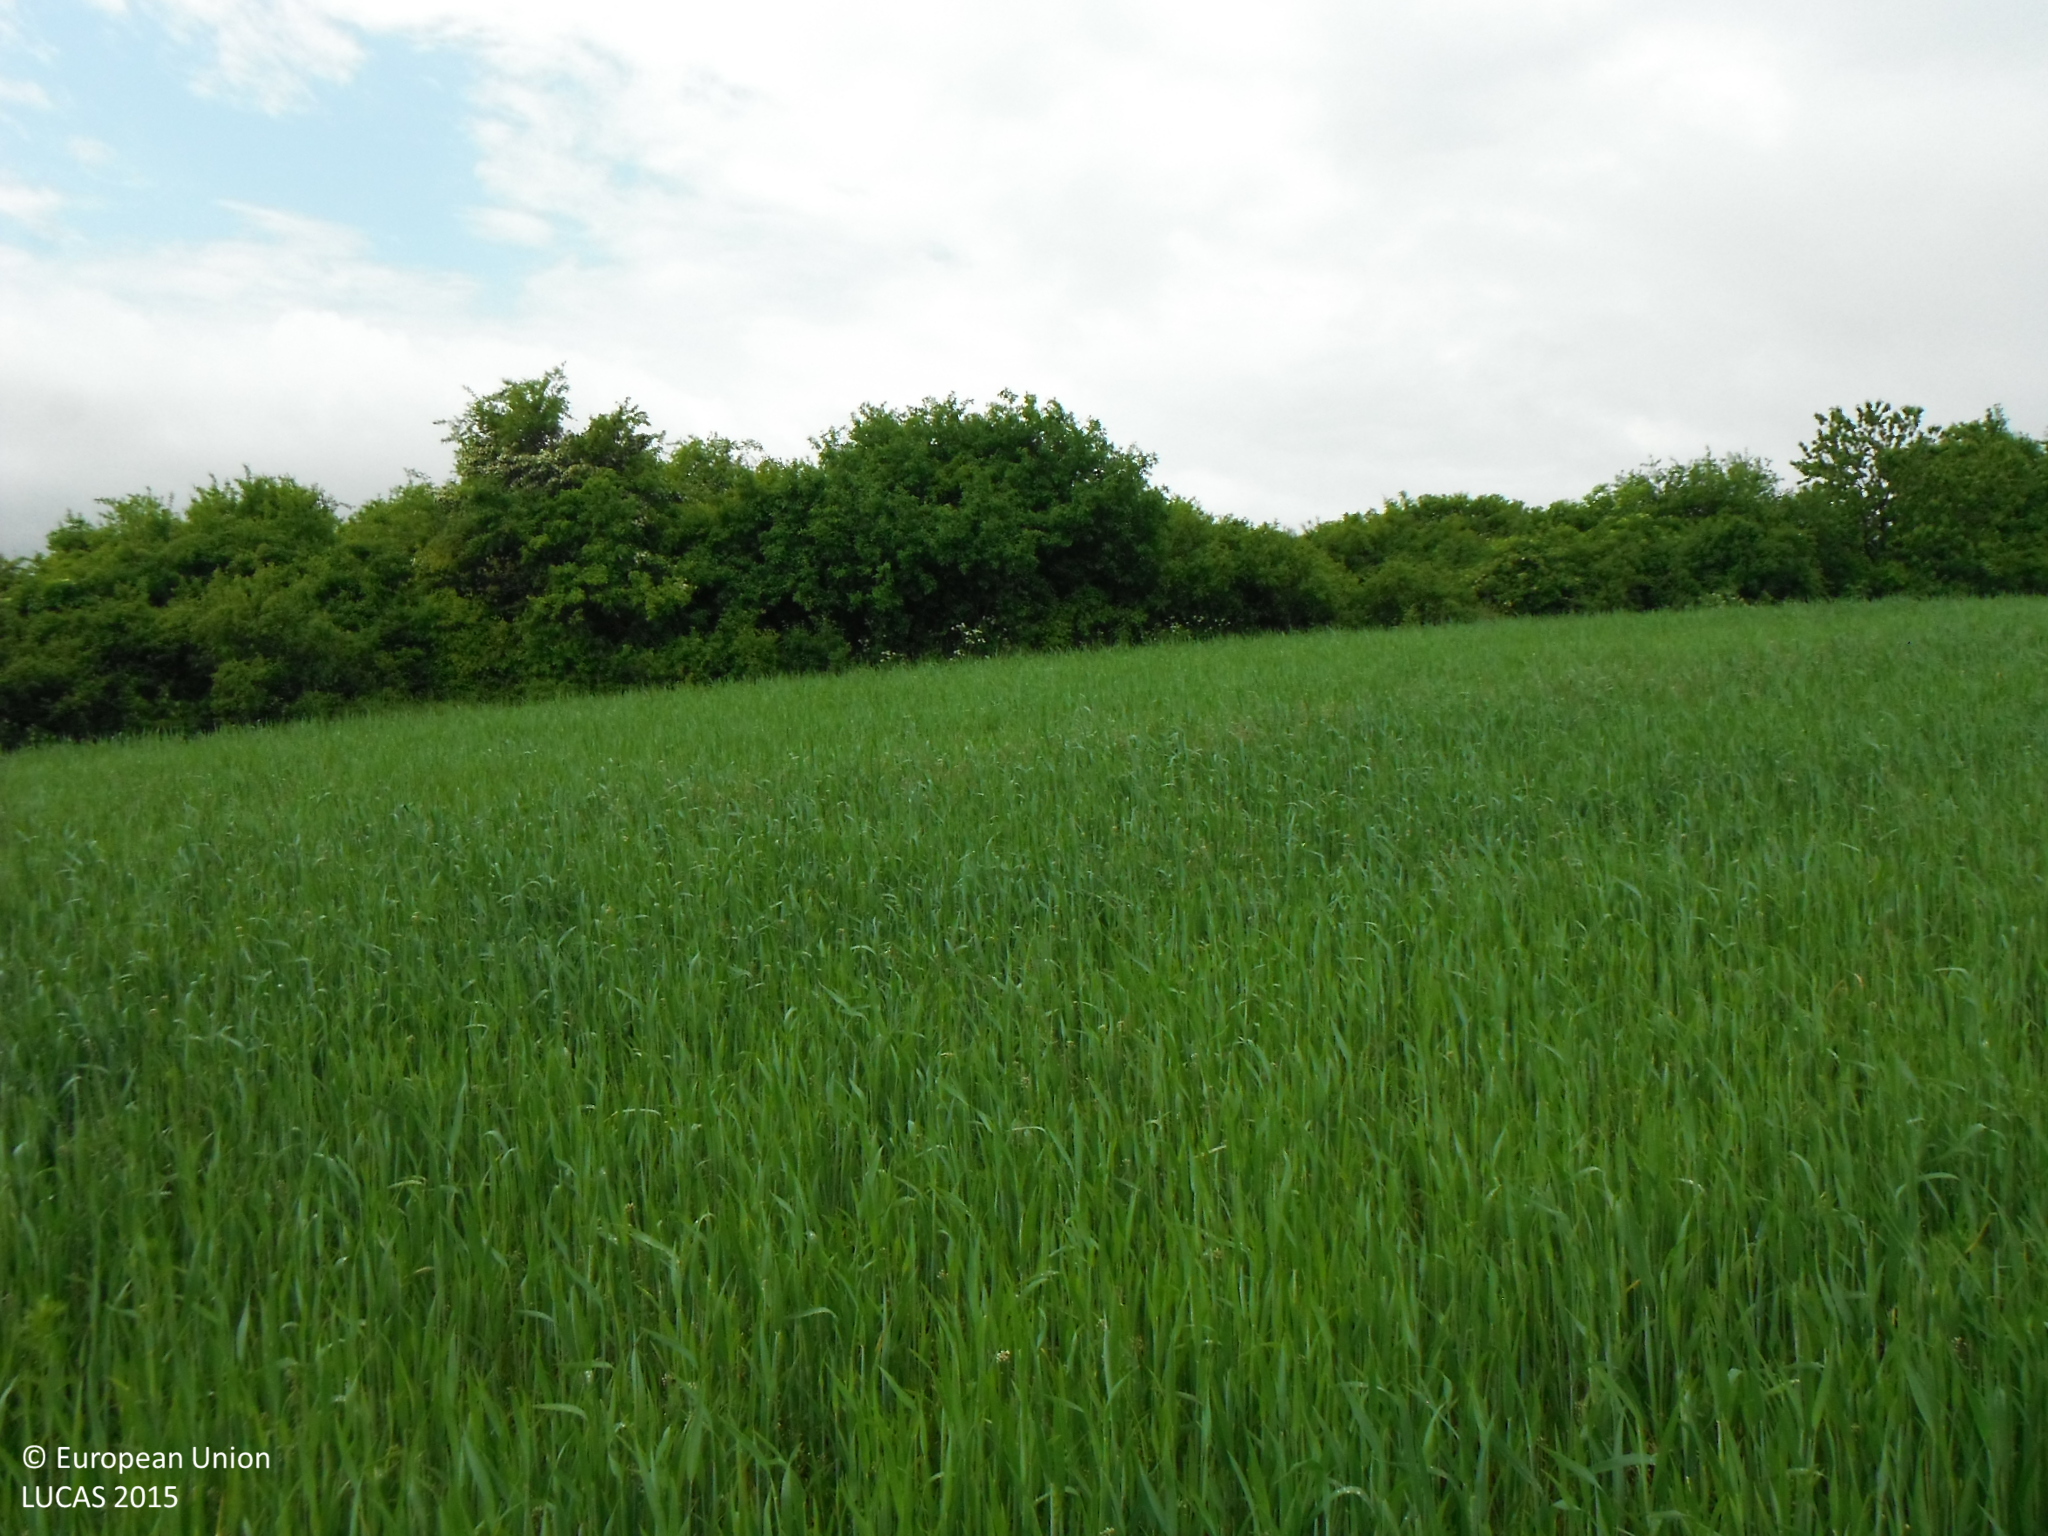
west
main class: Cropland
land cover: Common wheat
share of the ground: > 75 %
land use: Agriculture (excluding fallow land and kitchen gardens)
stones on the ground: < 10 %
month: May
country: SK
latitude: 49.1030
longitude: 21.2080
